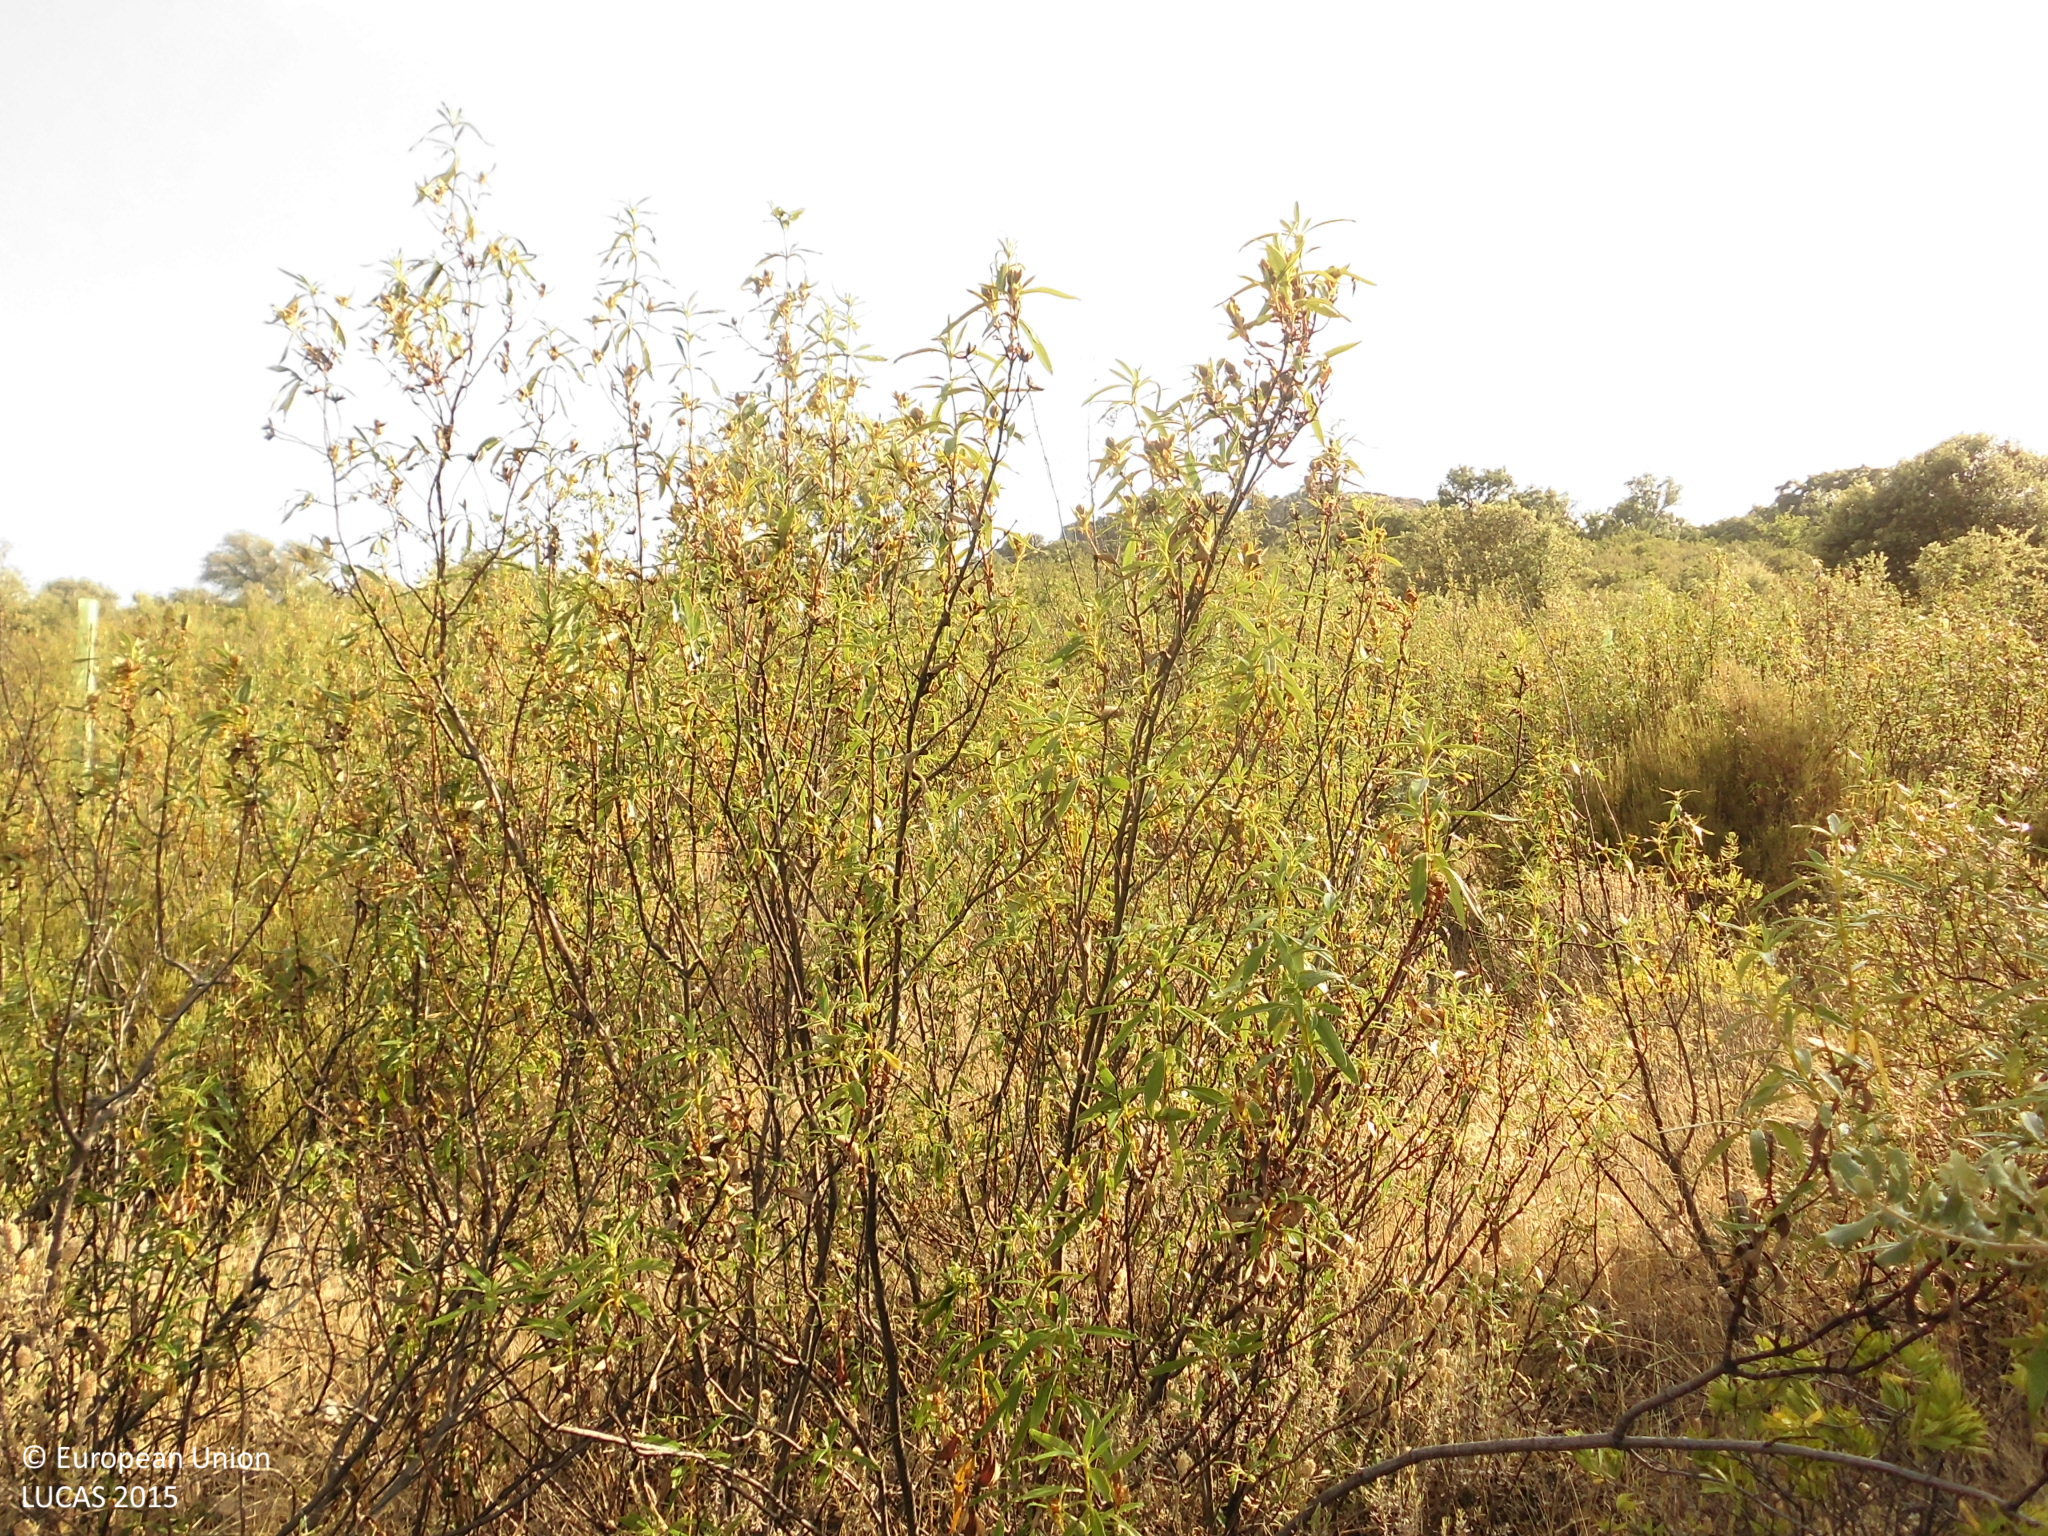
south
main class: Shrubland
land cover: Shrubland with sparse tree cover
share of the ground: > 75 %
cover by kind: shrubs 90 %, broadleaved forest trees 5 %, herbaceous plants 5 %
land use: Forestry
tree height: > 5 m
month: July
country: ES
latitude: 39.6520
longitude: -5.6150
